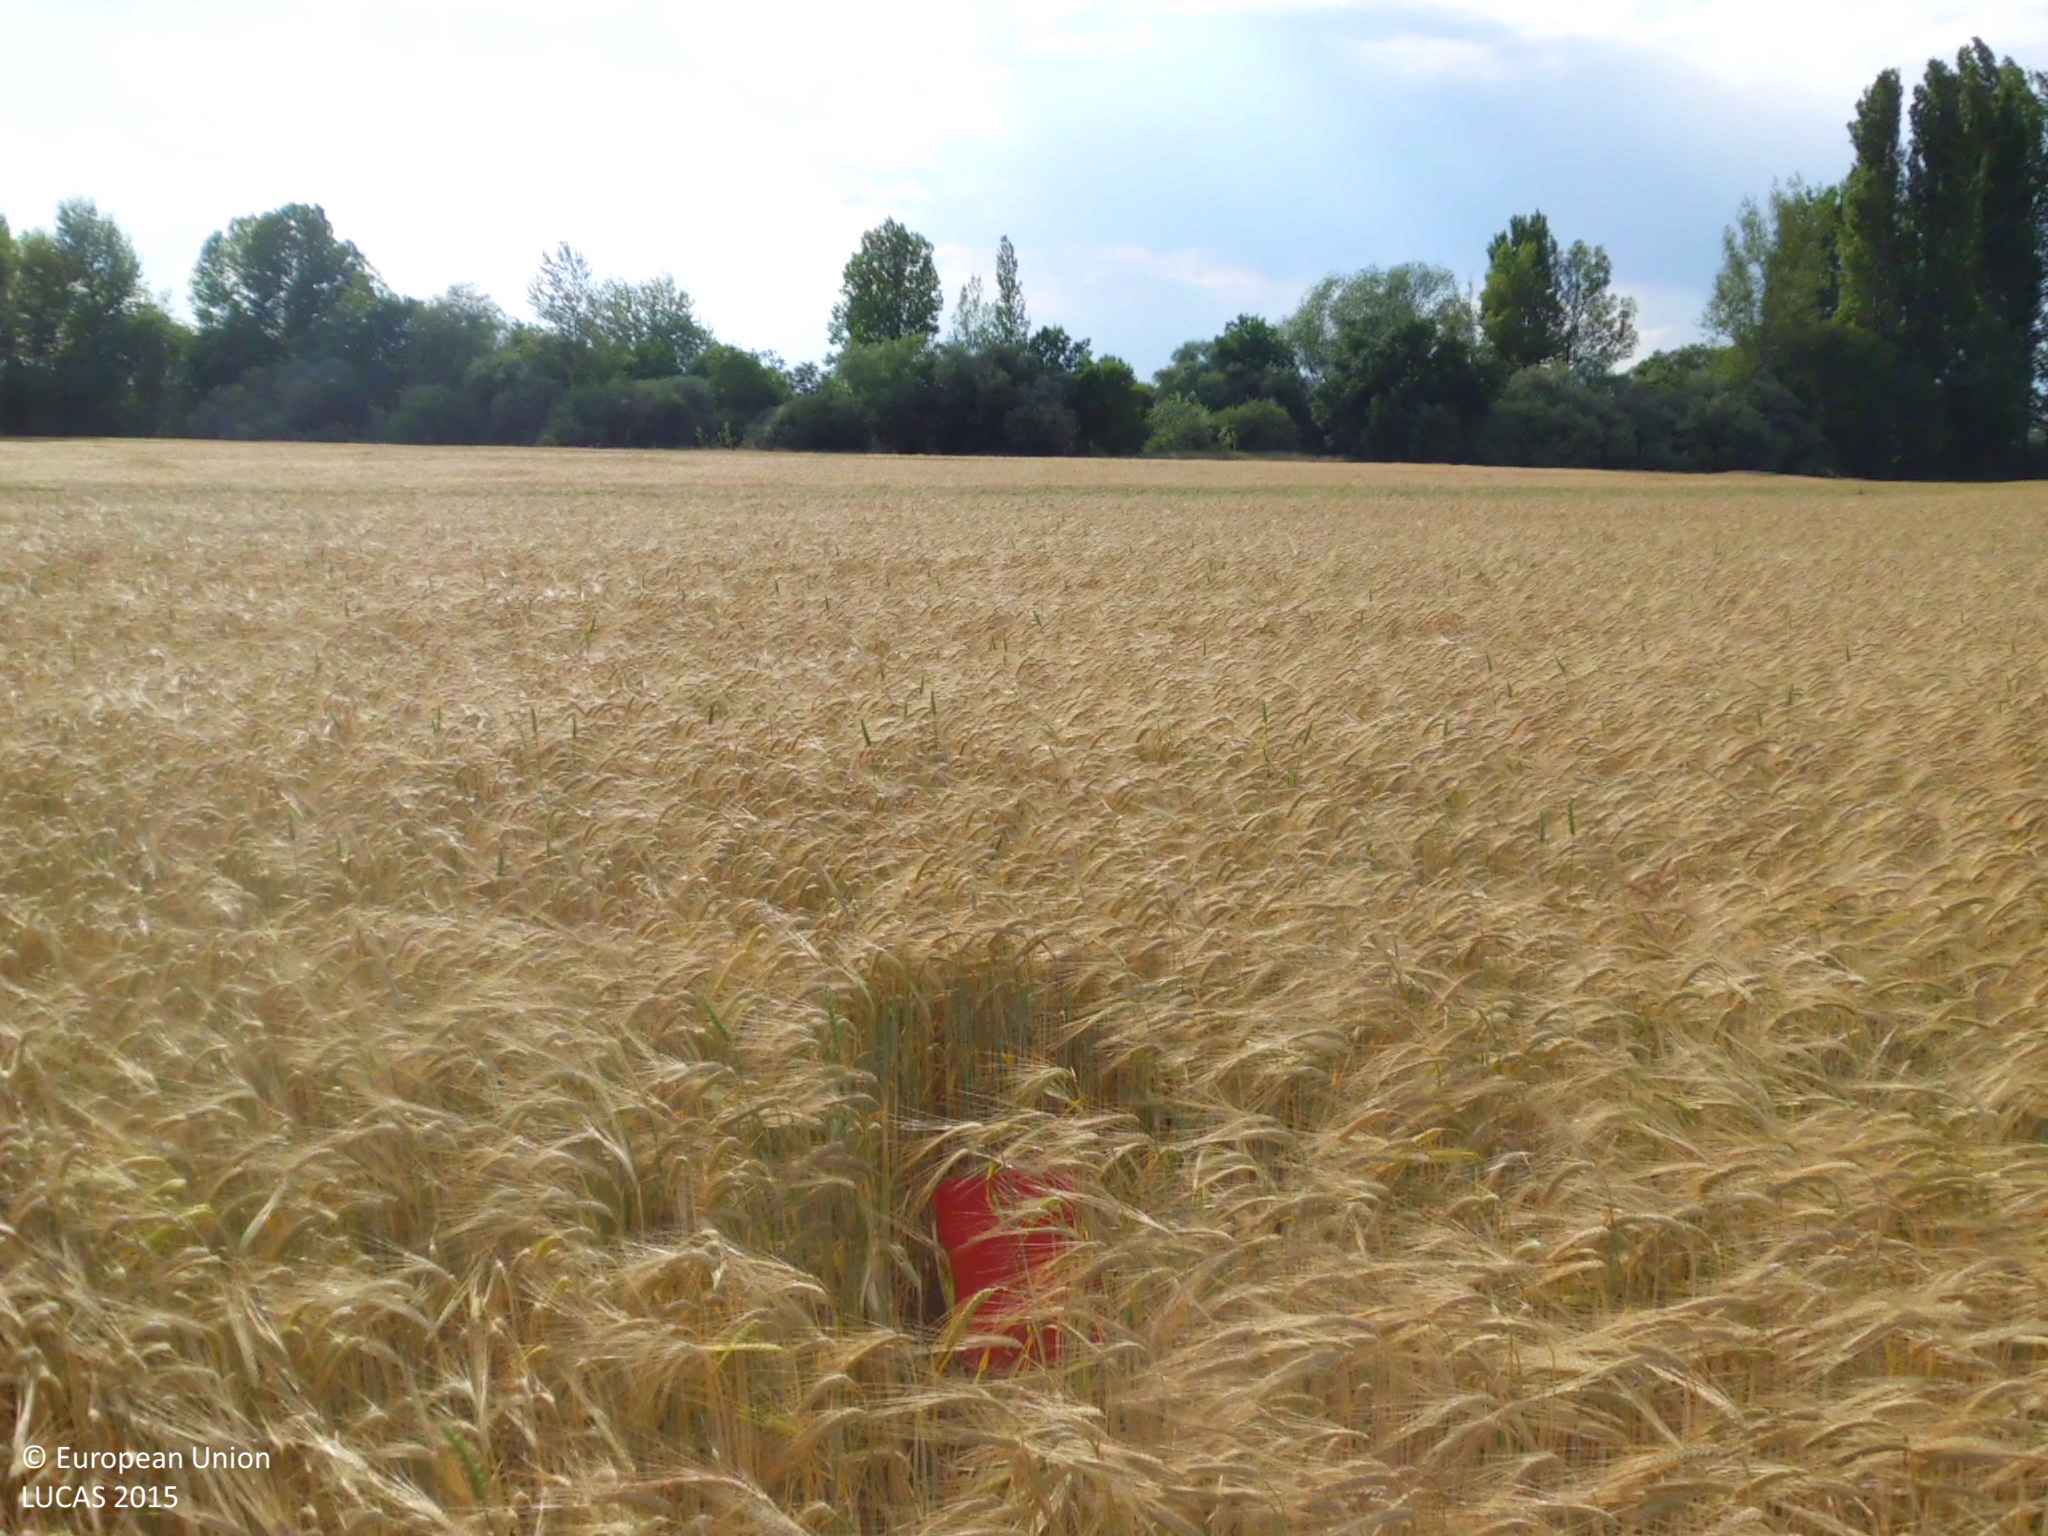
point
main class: Cropland
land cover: Barley
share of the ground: > 75 %
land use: Agriculture (excluding fallow land and kitchen gardens)
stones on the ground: < 10 %
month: June
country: ES
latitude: 42.5020
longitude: -4.3717
